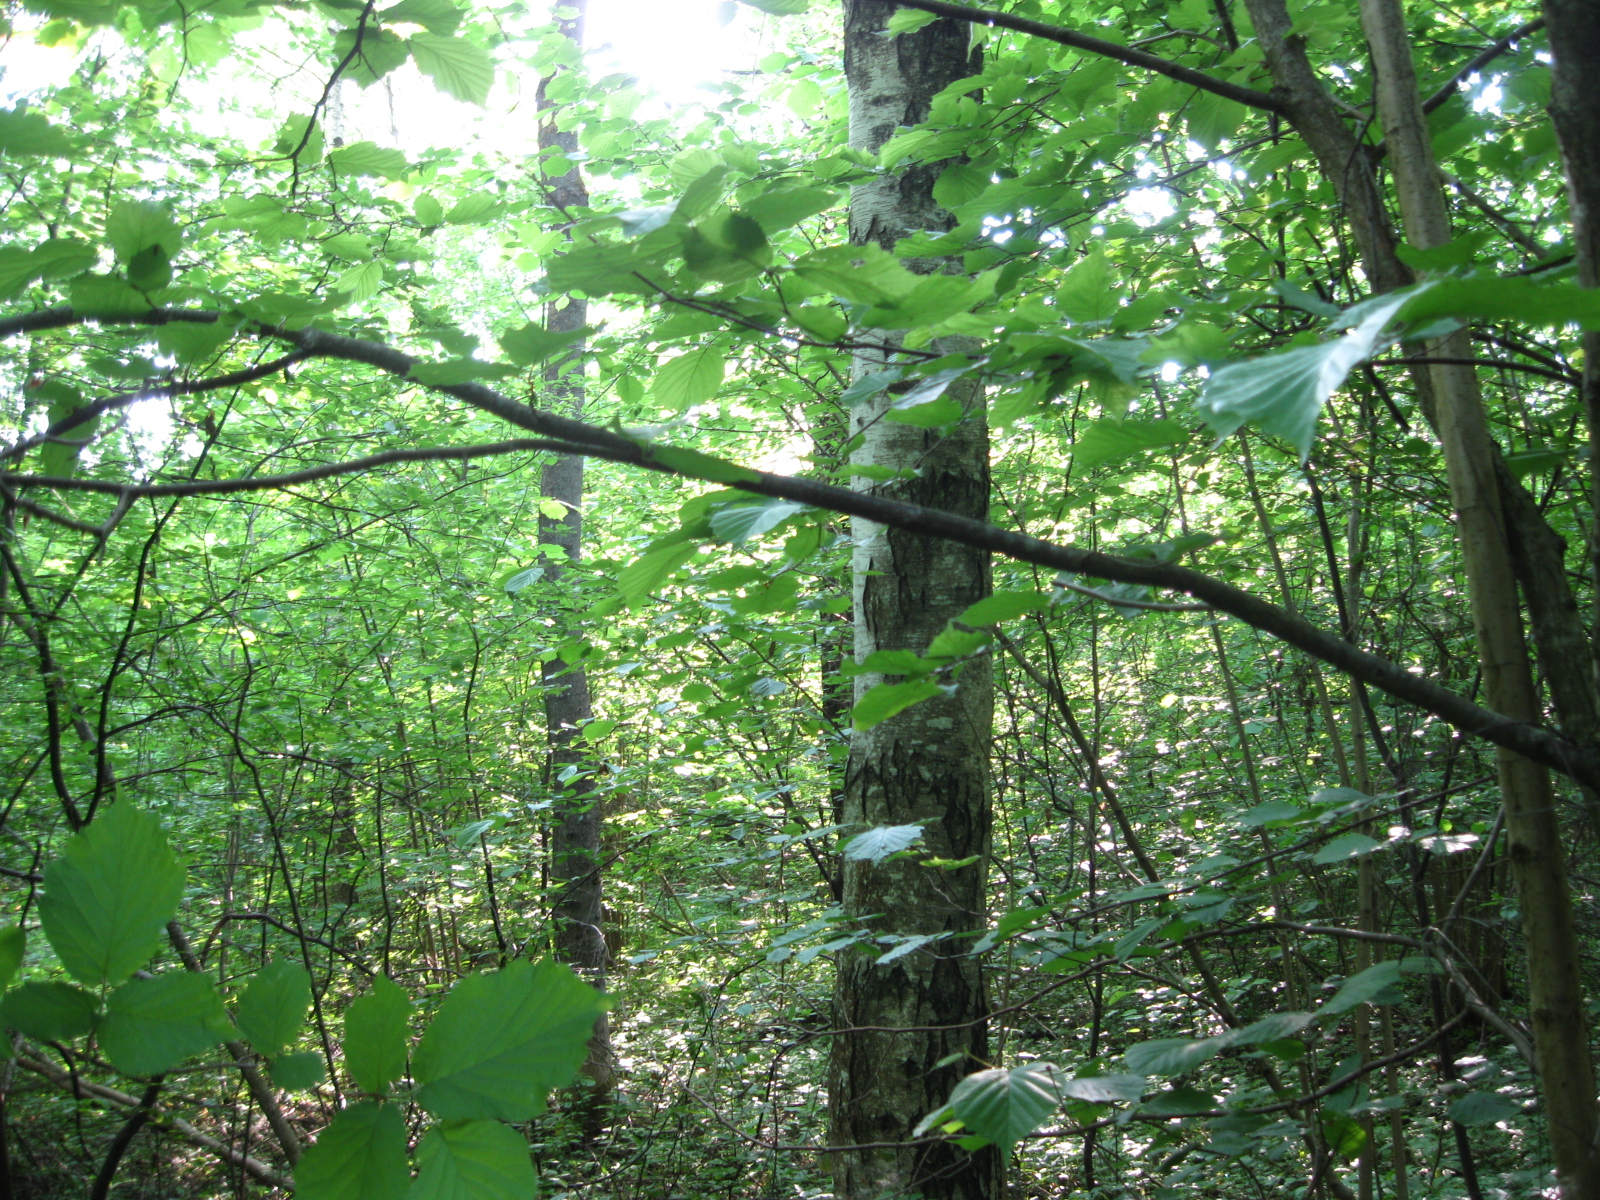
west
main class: Woodland
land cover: Broadleaved woodland
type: non-riverine alder, birch or aspen forest
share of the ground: > 75 %
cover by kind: broadleaved forest trees 80 %, herbaceous plants 15 %, shrubs 5 %
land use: Forestry
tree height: > 5 m
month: June
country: LT
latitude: 55.9026
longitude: 23.8886
